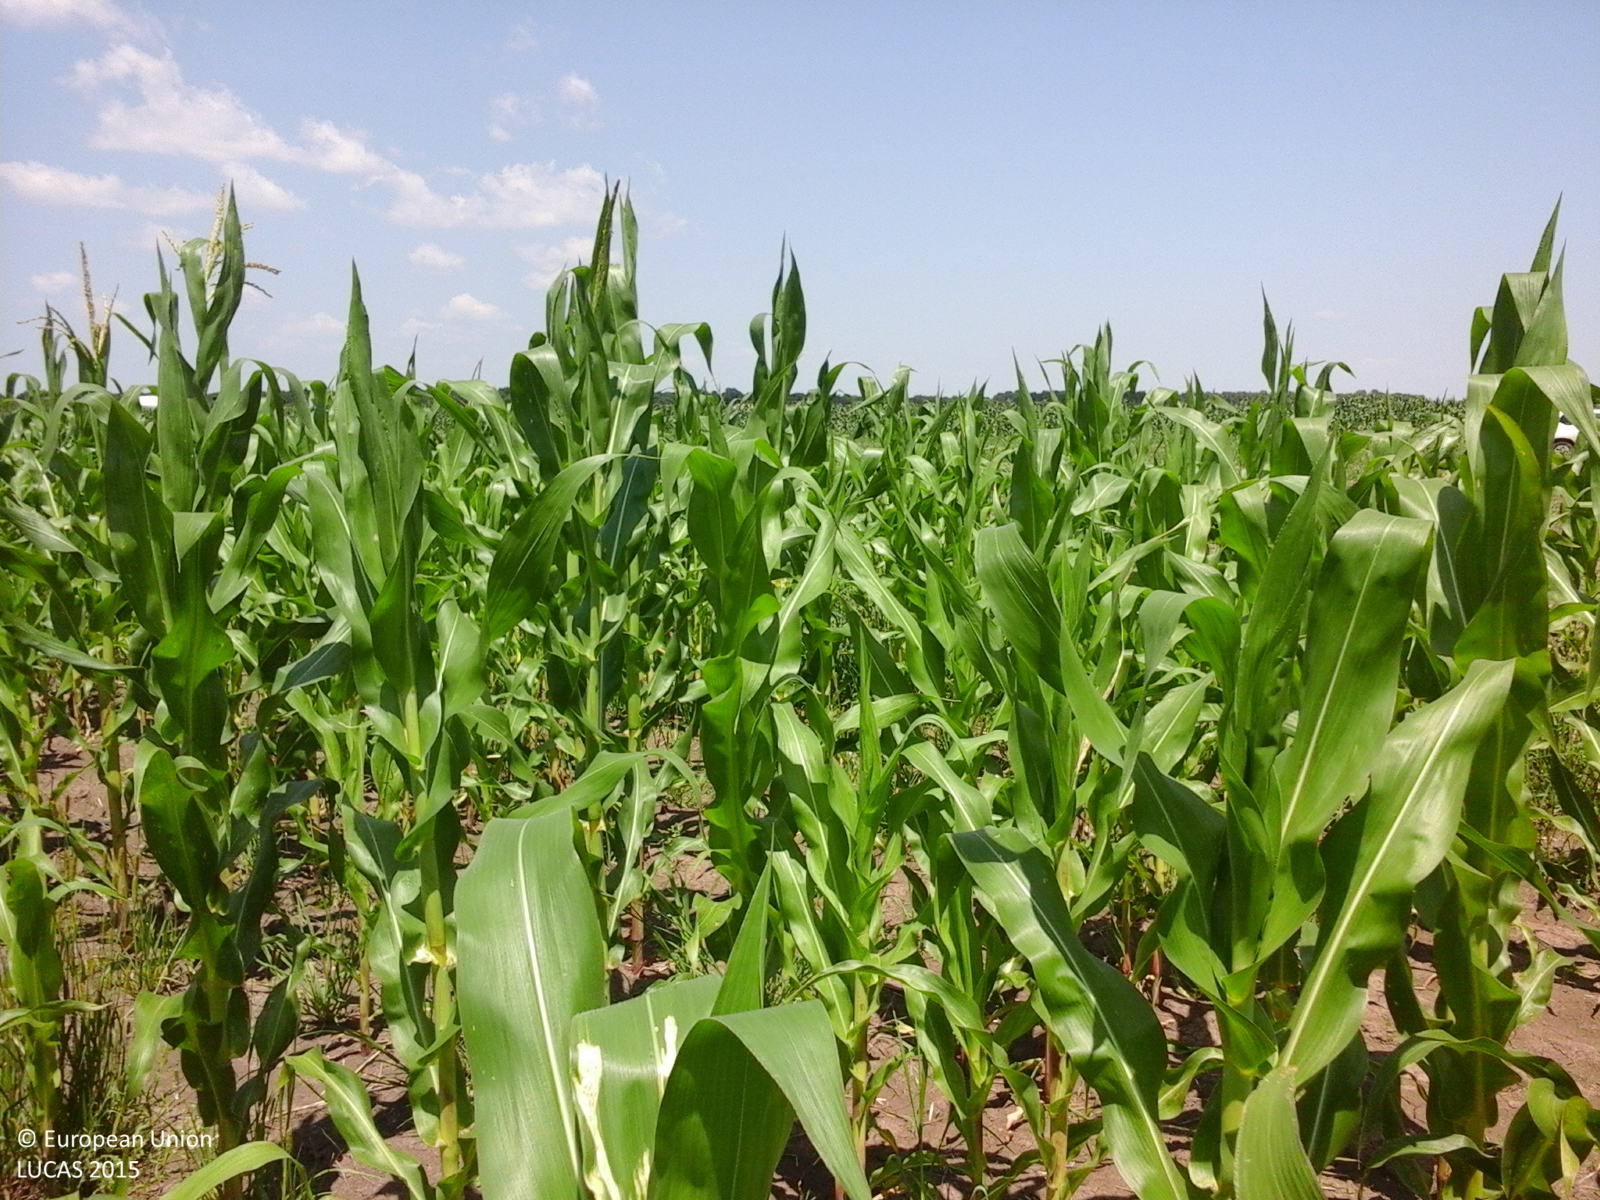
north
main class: Cropland
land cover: Maize
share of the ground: 50 - 75 %
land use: Agriculture (excluding fallow land and kitchen gardens)
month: July
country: RO
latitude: 44.5010
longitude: 24.4714
